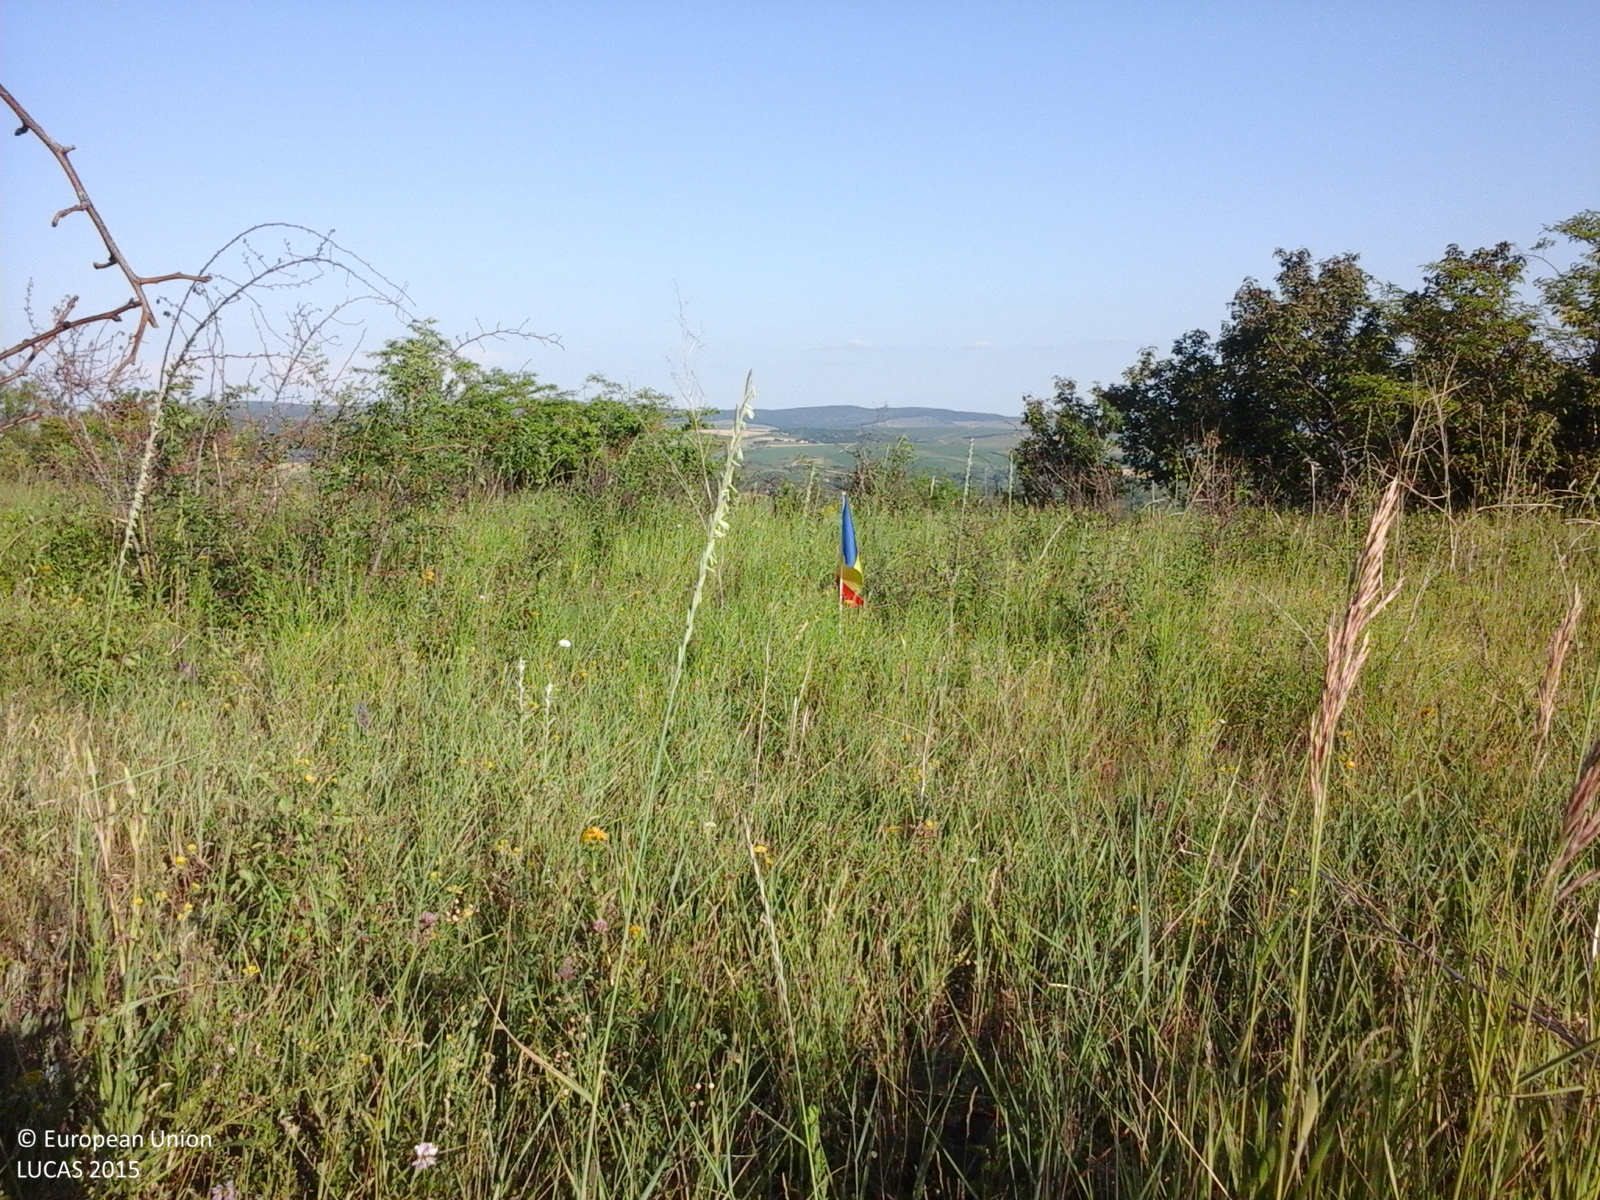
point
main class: Shrubland
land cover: Shrubland with sparse tree cover
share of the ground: > 75 %
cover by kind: herbaceous plants 50 %, shrubs 45 %, broadleaved forest trees 5 %
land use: Agriculture (excluding fallow land and kitchen gardens)
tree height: < 5 m
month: June
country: RO
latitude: 46.9305
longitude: 27.5444
